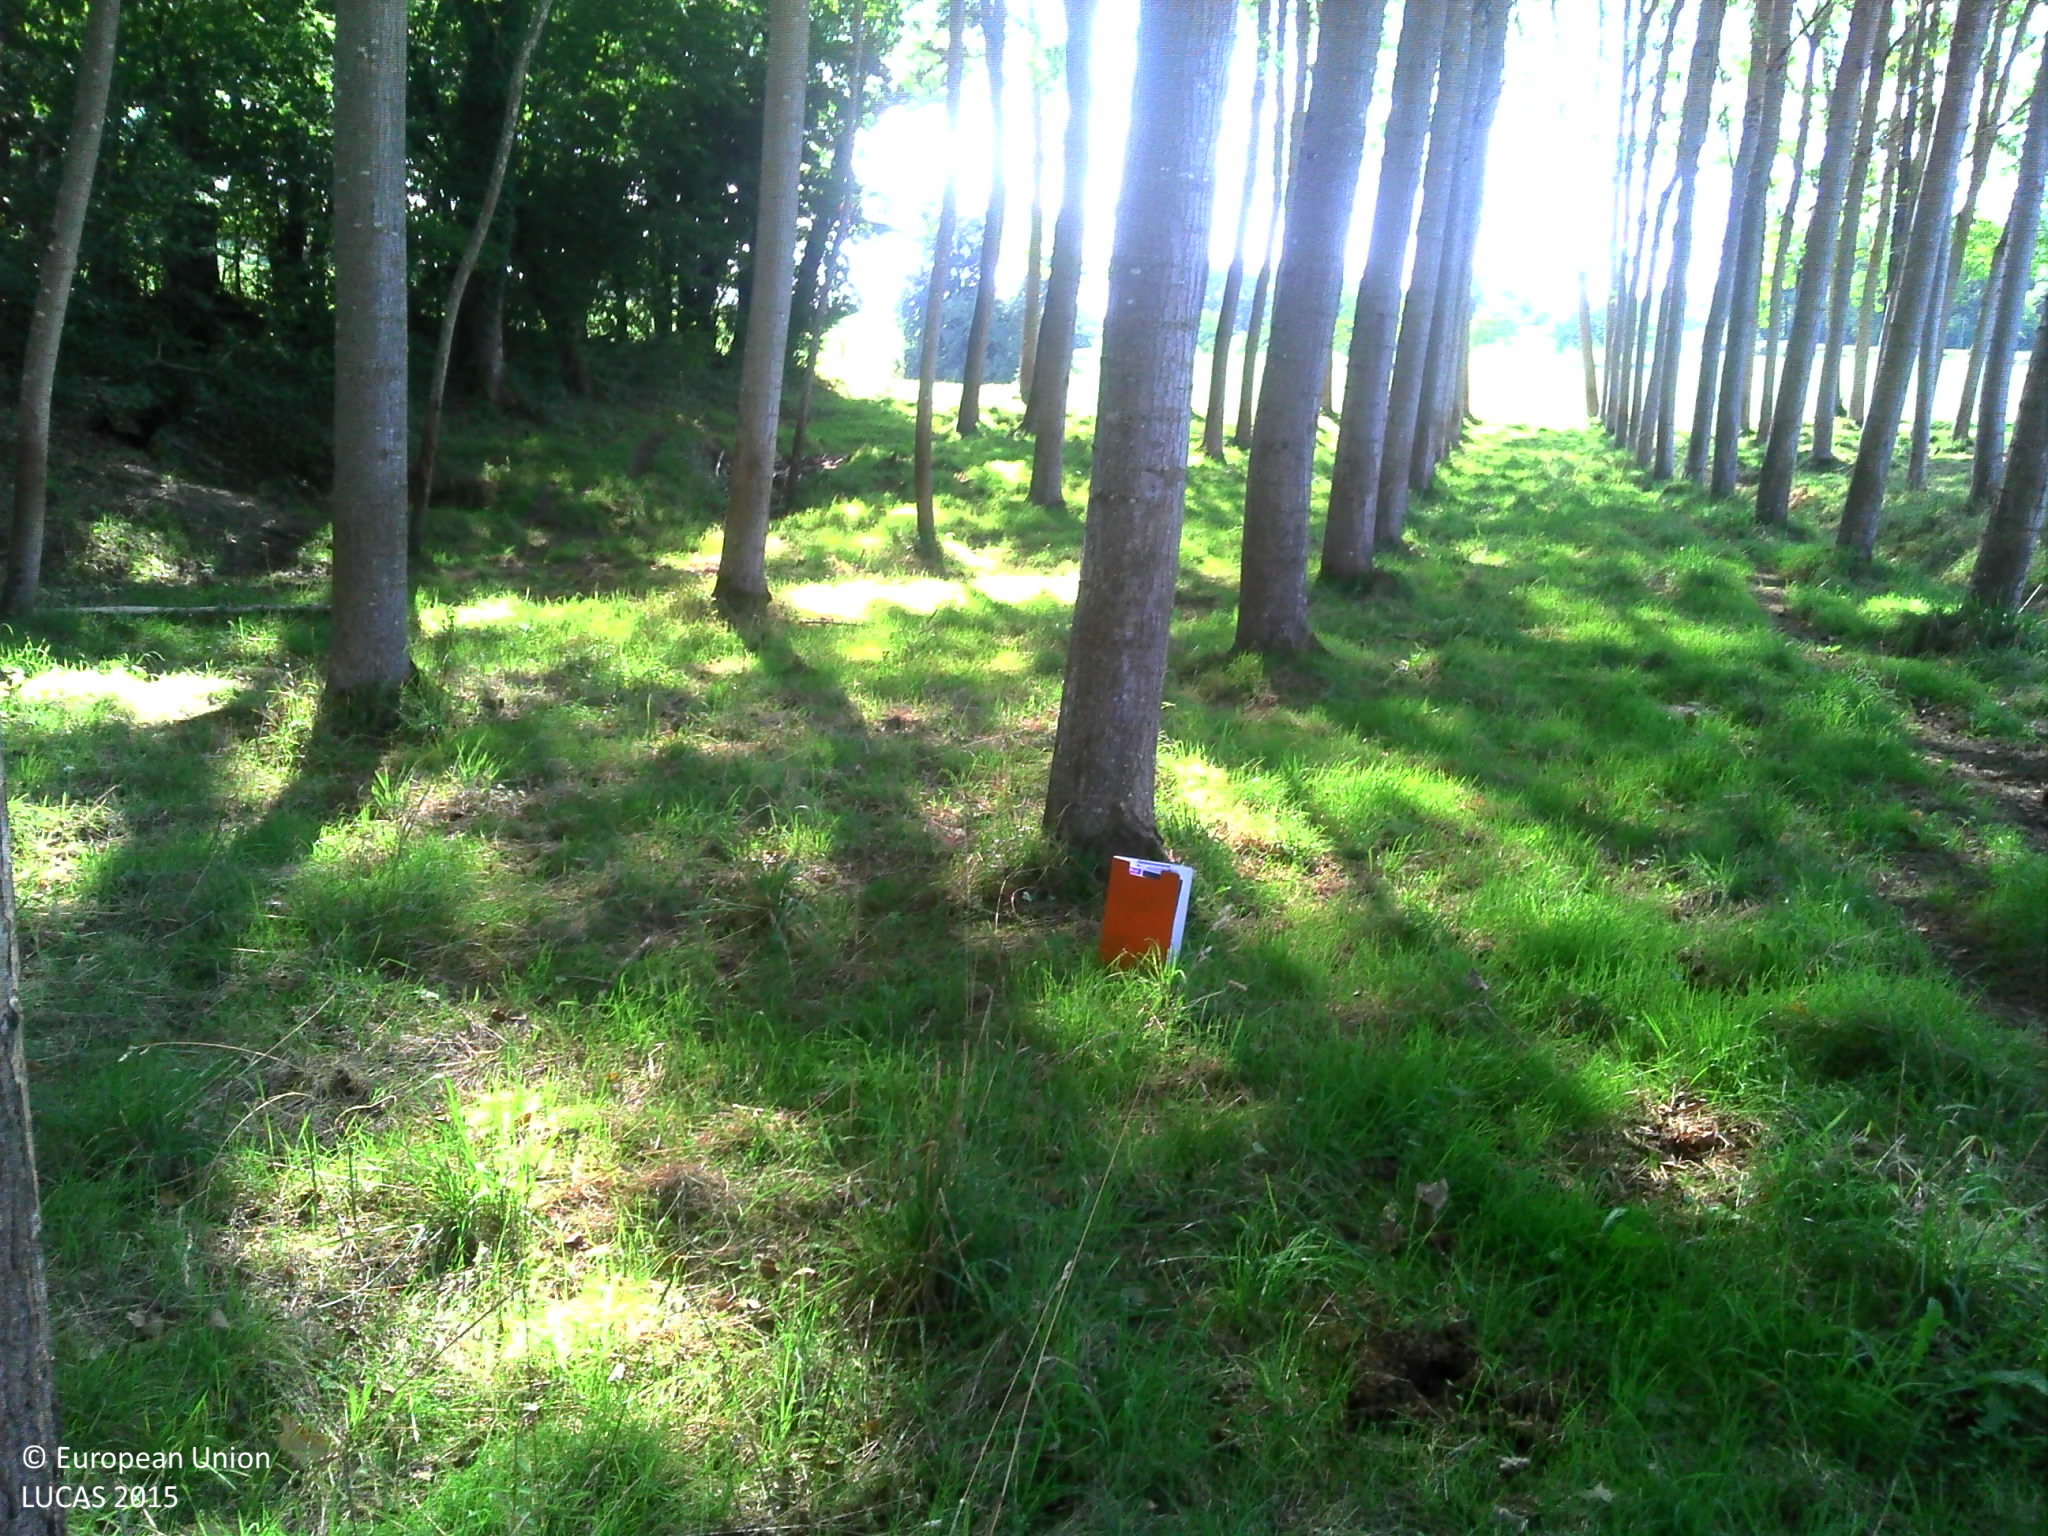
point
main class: Woodland
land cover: Broadleaved woodland
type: exotic forest
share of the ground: 50 - 75 %
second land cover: Grassland without tree/shrub cover
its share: 25 - 50 %
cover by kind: broadleaved forest trees 70 %, herbaceous plants 30 %
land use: Agriculture (excluding fallow land and kitchen gardens)
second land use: Forestry
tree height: > 5 m
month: August
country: FR
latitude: 44.6297
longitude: 1.2103
